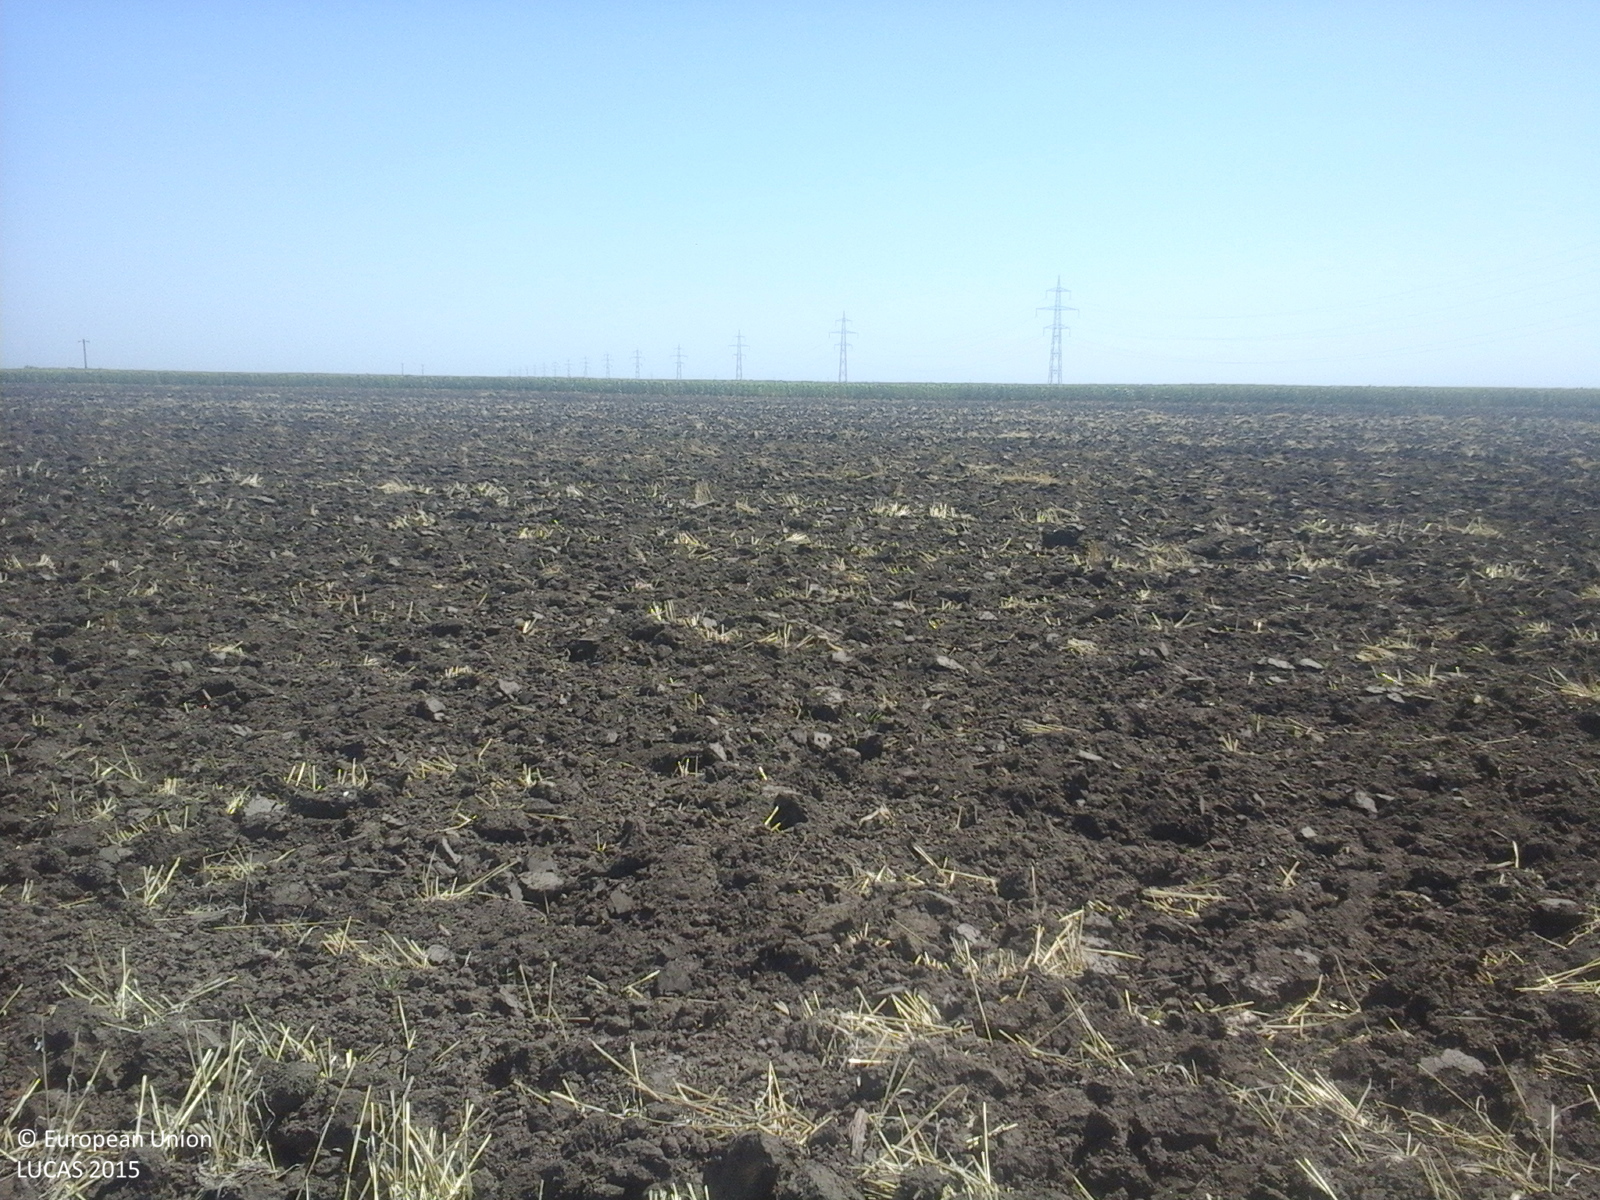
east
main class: Cropland
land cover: Durum wheat
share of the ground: < 10 %
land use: Agriculture (excluding fallow land and kitchen gardens)
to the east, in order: Durum wheat; Sunflower
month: July
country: RO
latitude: 44.4044
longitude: 26.6813
